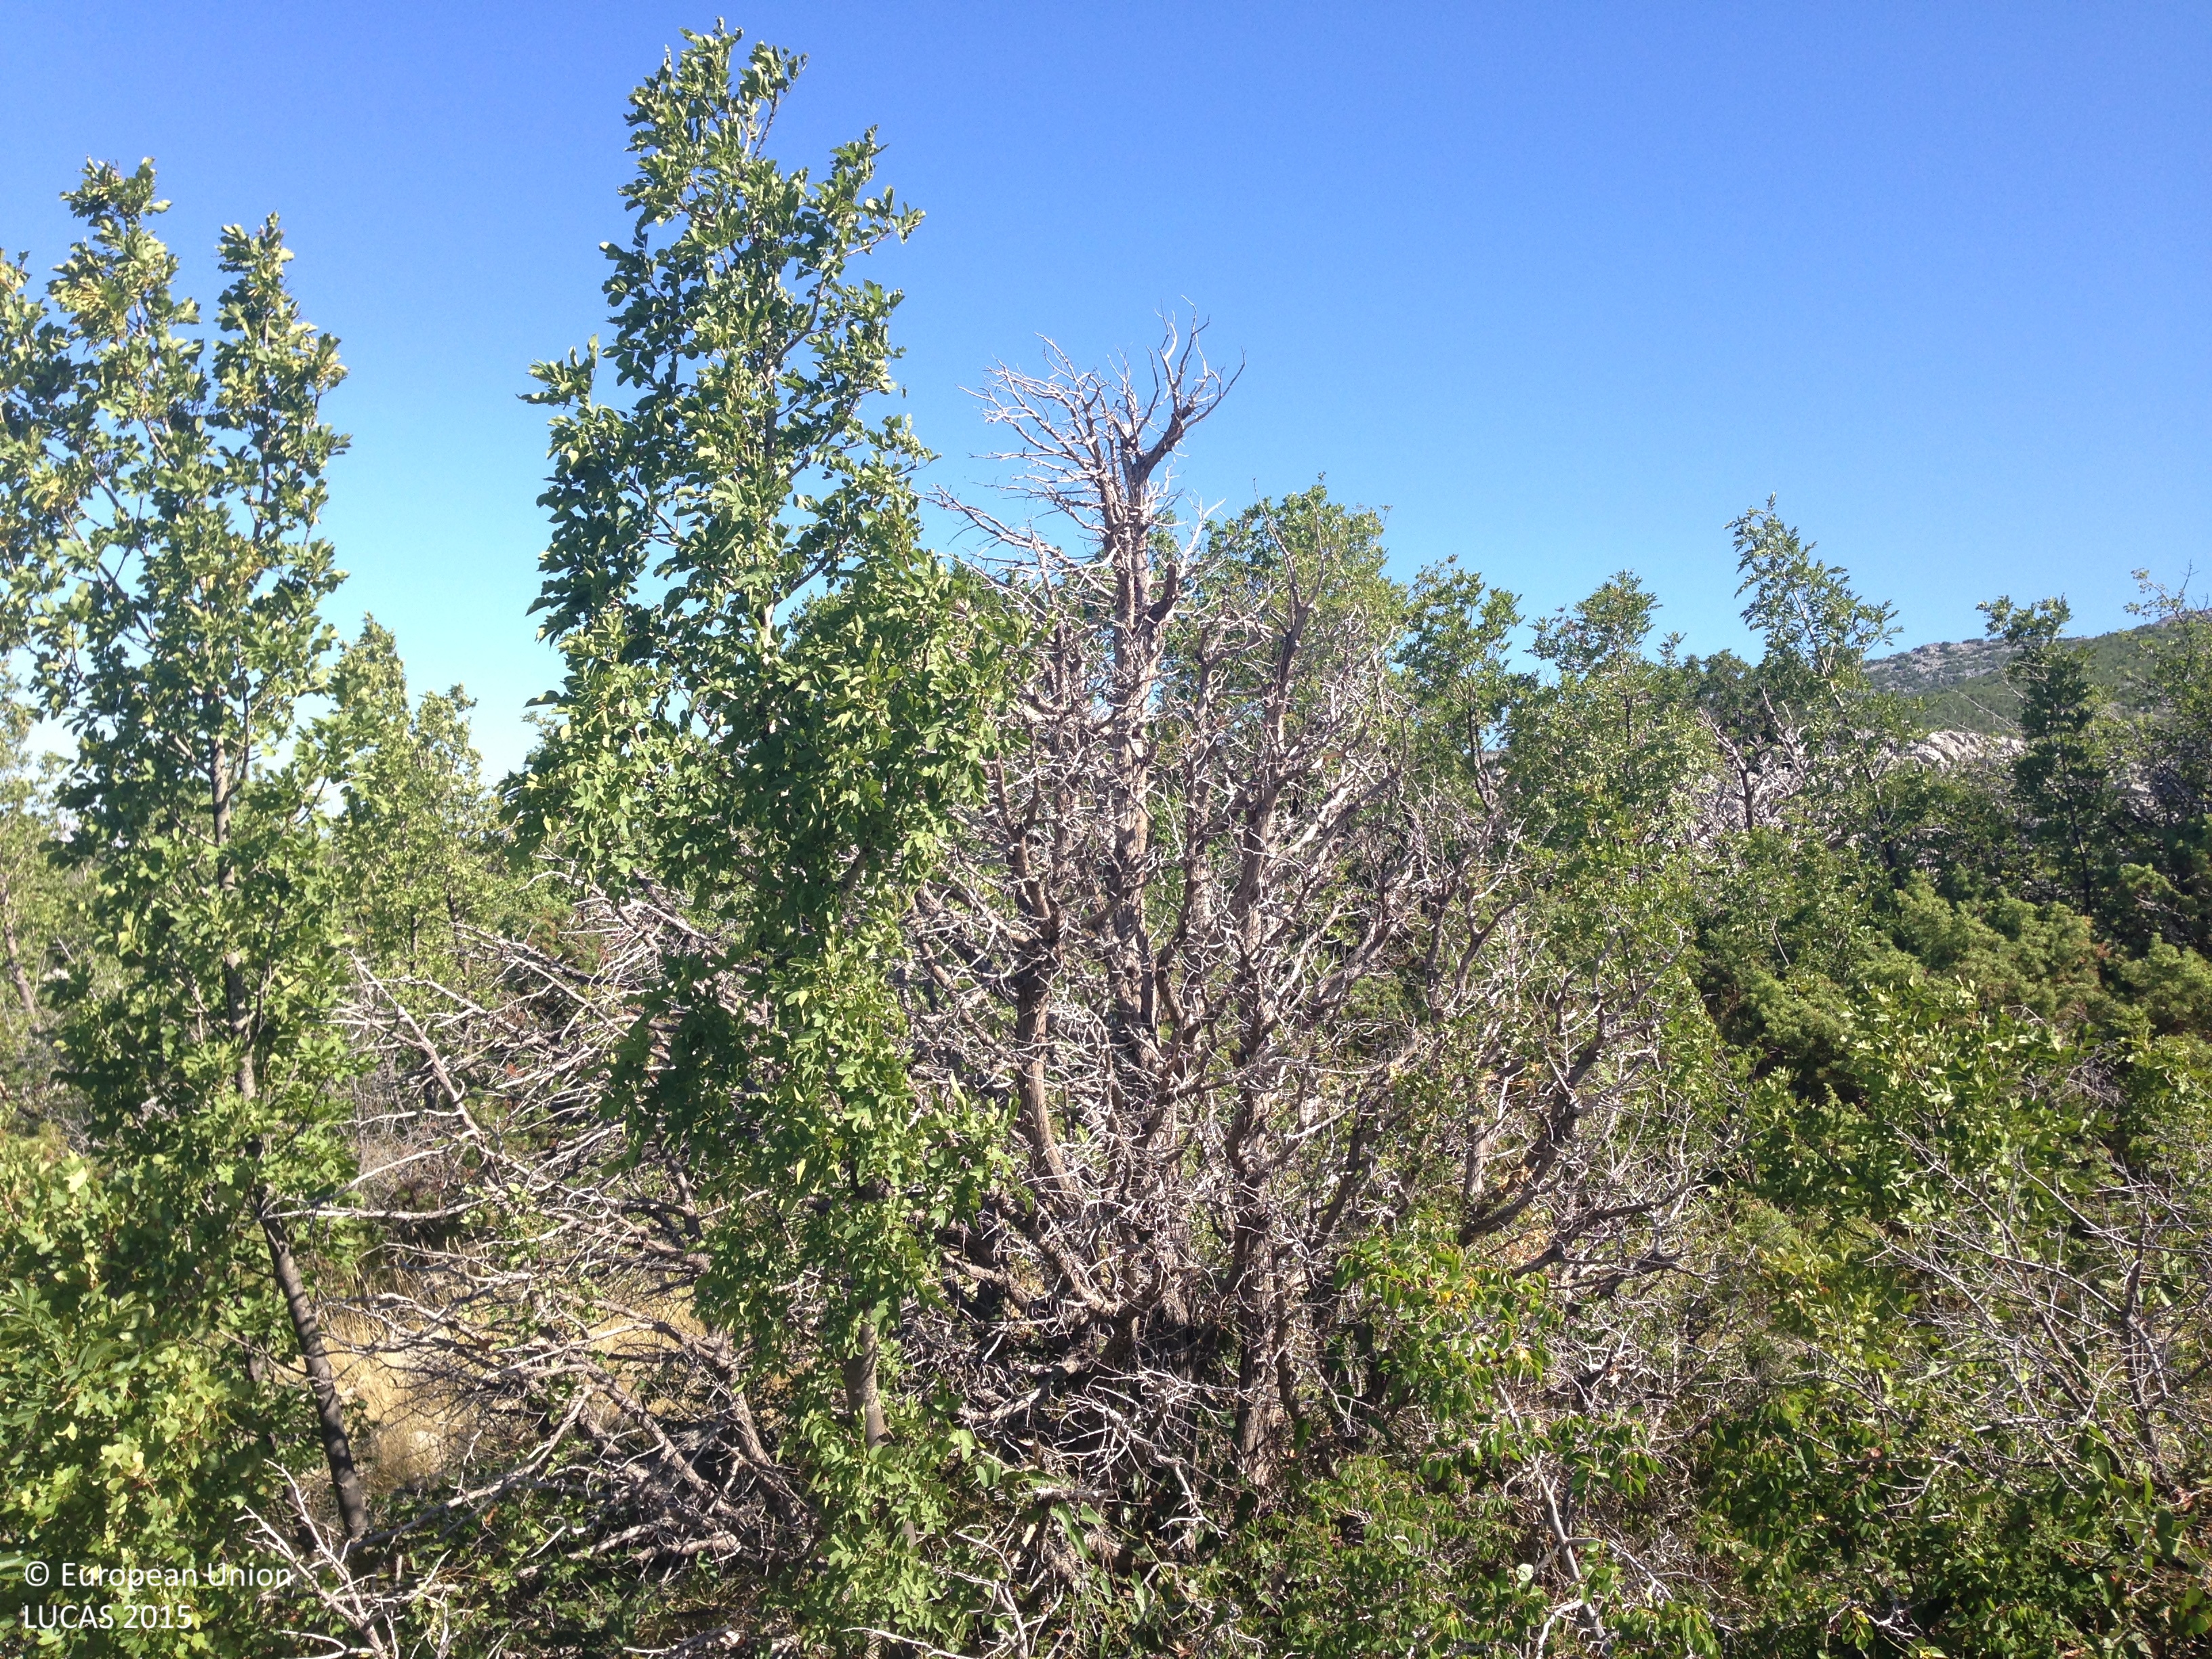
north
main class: Woodland
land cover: Broadleaved woodland
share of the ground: 25 - 50 %
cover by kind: consolidated bare surface 30 %, broadleaved forest trees 25 %, shrubs 25 %, herbaceous plants 10 %, unconsolidated bare surface 10 %
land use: Semi-natural and natural areas not in use
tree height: < 5 m
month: July
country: HR
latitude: 44.7403
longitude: 14.9063
